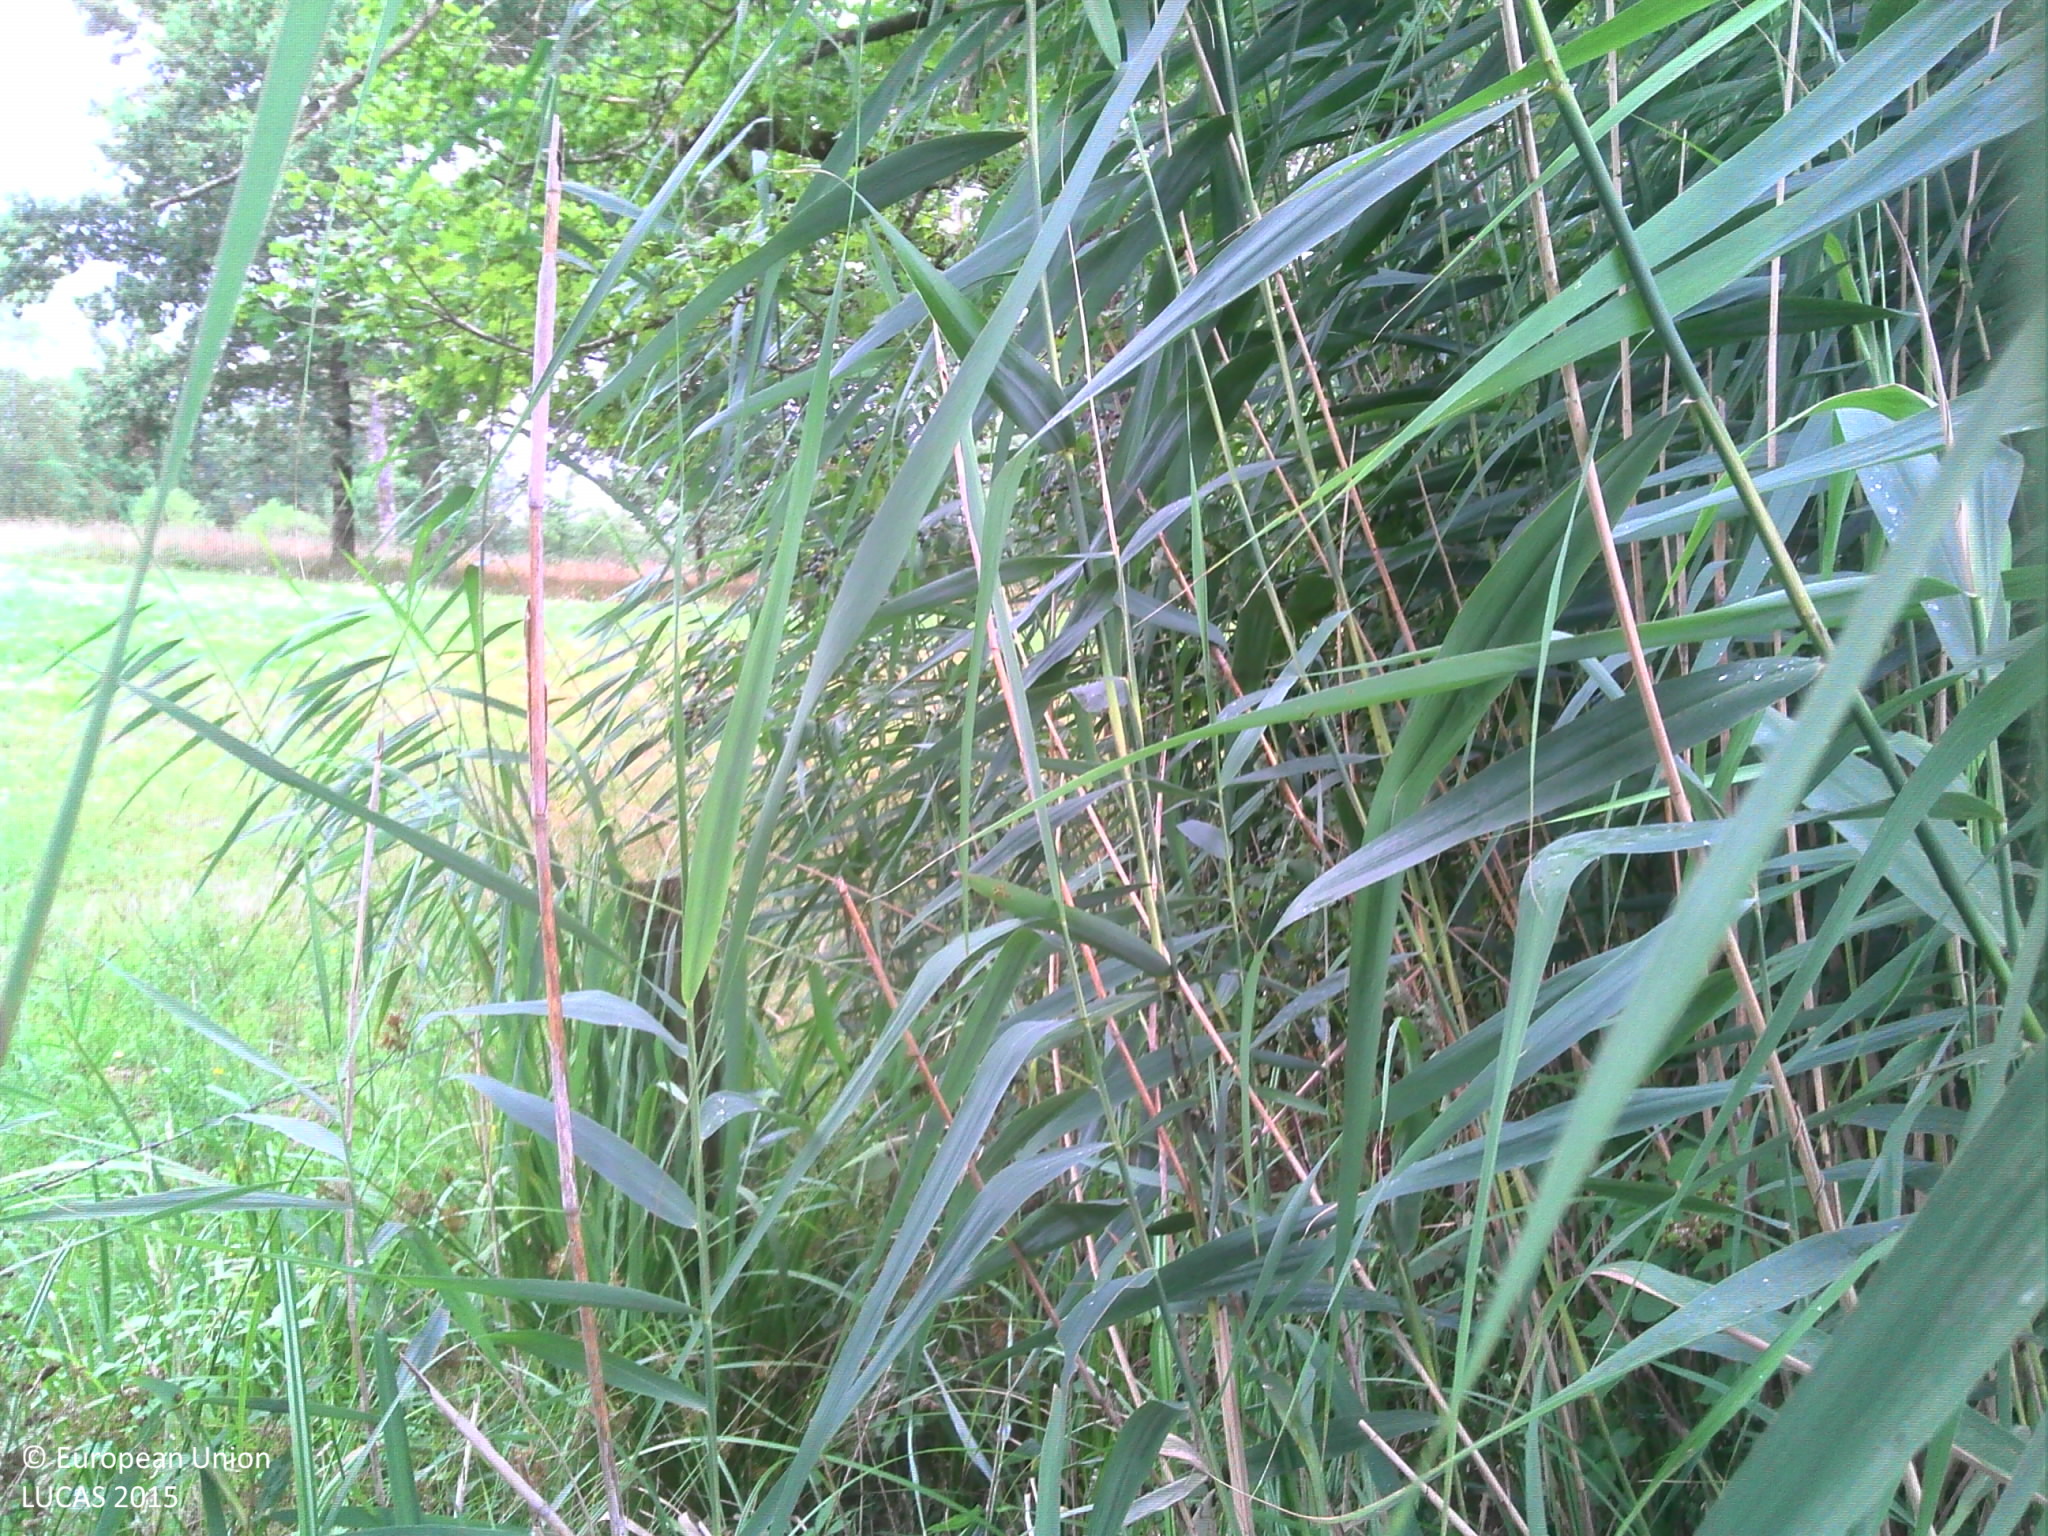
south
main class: Grassland
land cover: Grassland without tree/shrub cover
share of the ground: > 75 %
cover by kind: herbaceous plants 100 %
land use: Agriculture (excluding fallow land and kitchen gardens)
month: July
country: FR
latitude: 46.6372
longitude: 5.1294
